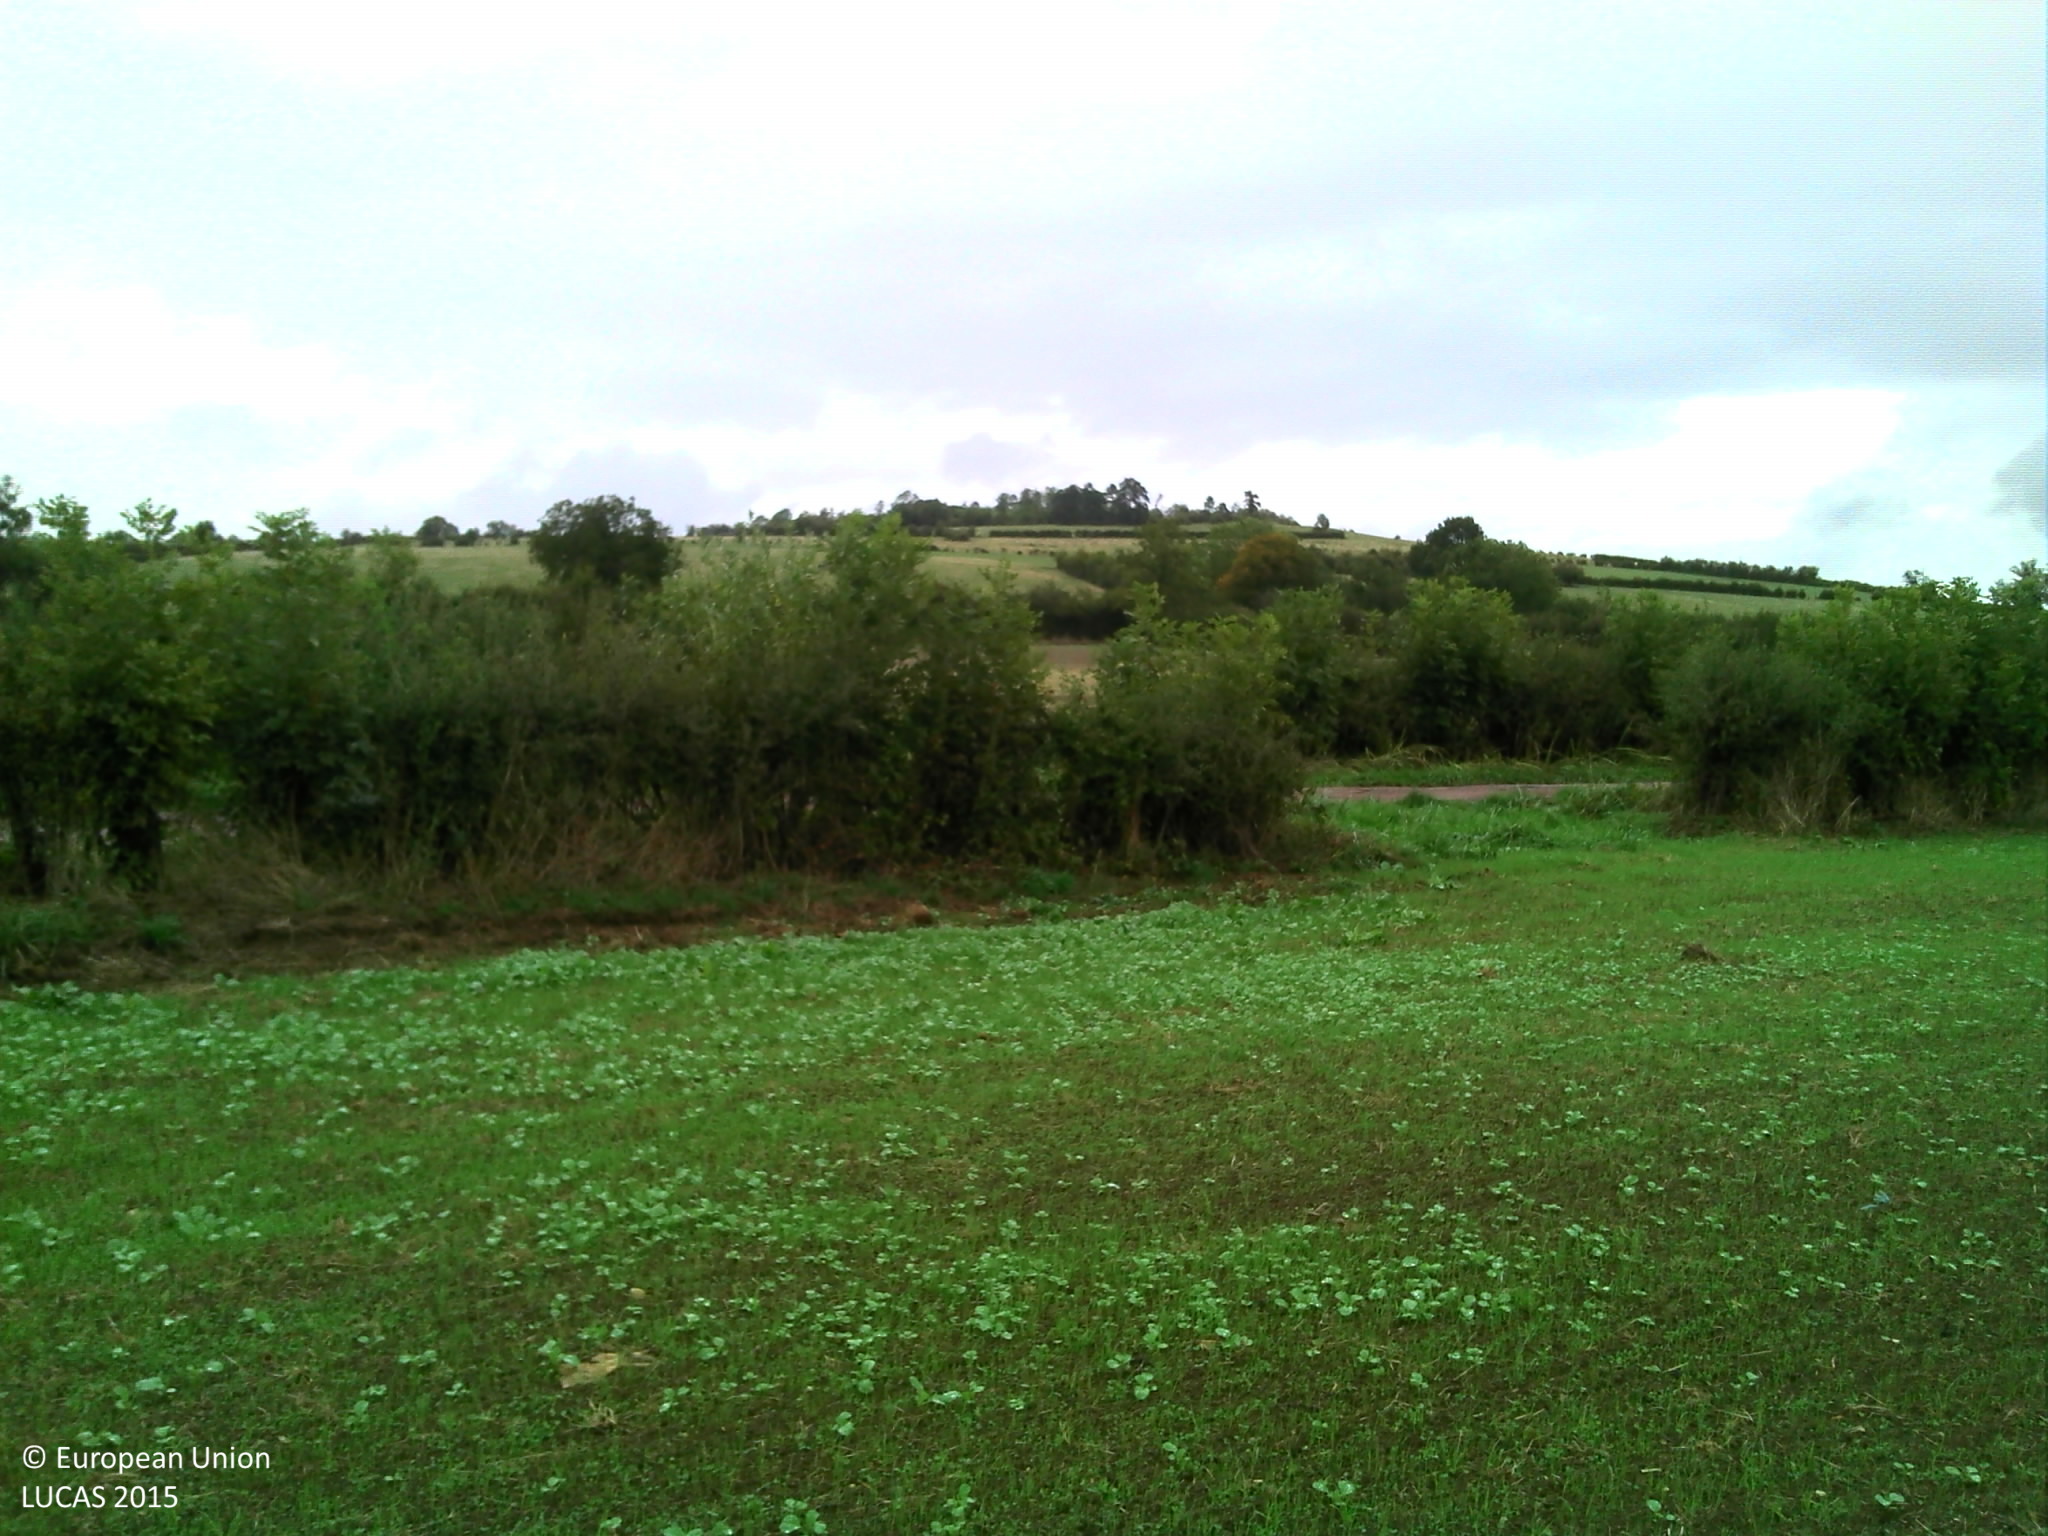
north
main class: Cropland
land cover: Rape and turnip rape
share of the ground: 25 - 50 %
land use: Agriculture (excluding fallow land and kitchen gardens)
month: September
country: FR
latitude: 47.3264
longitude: 4.4552
